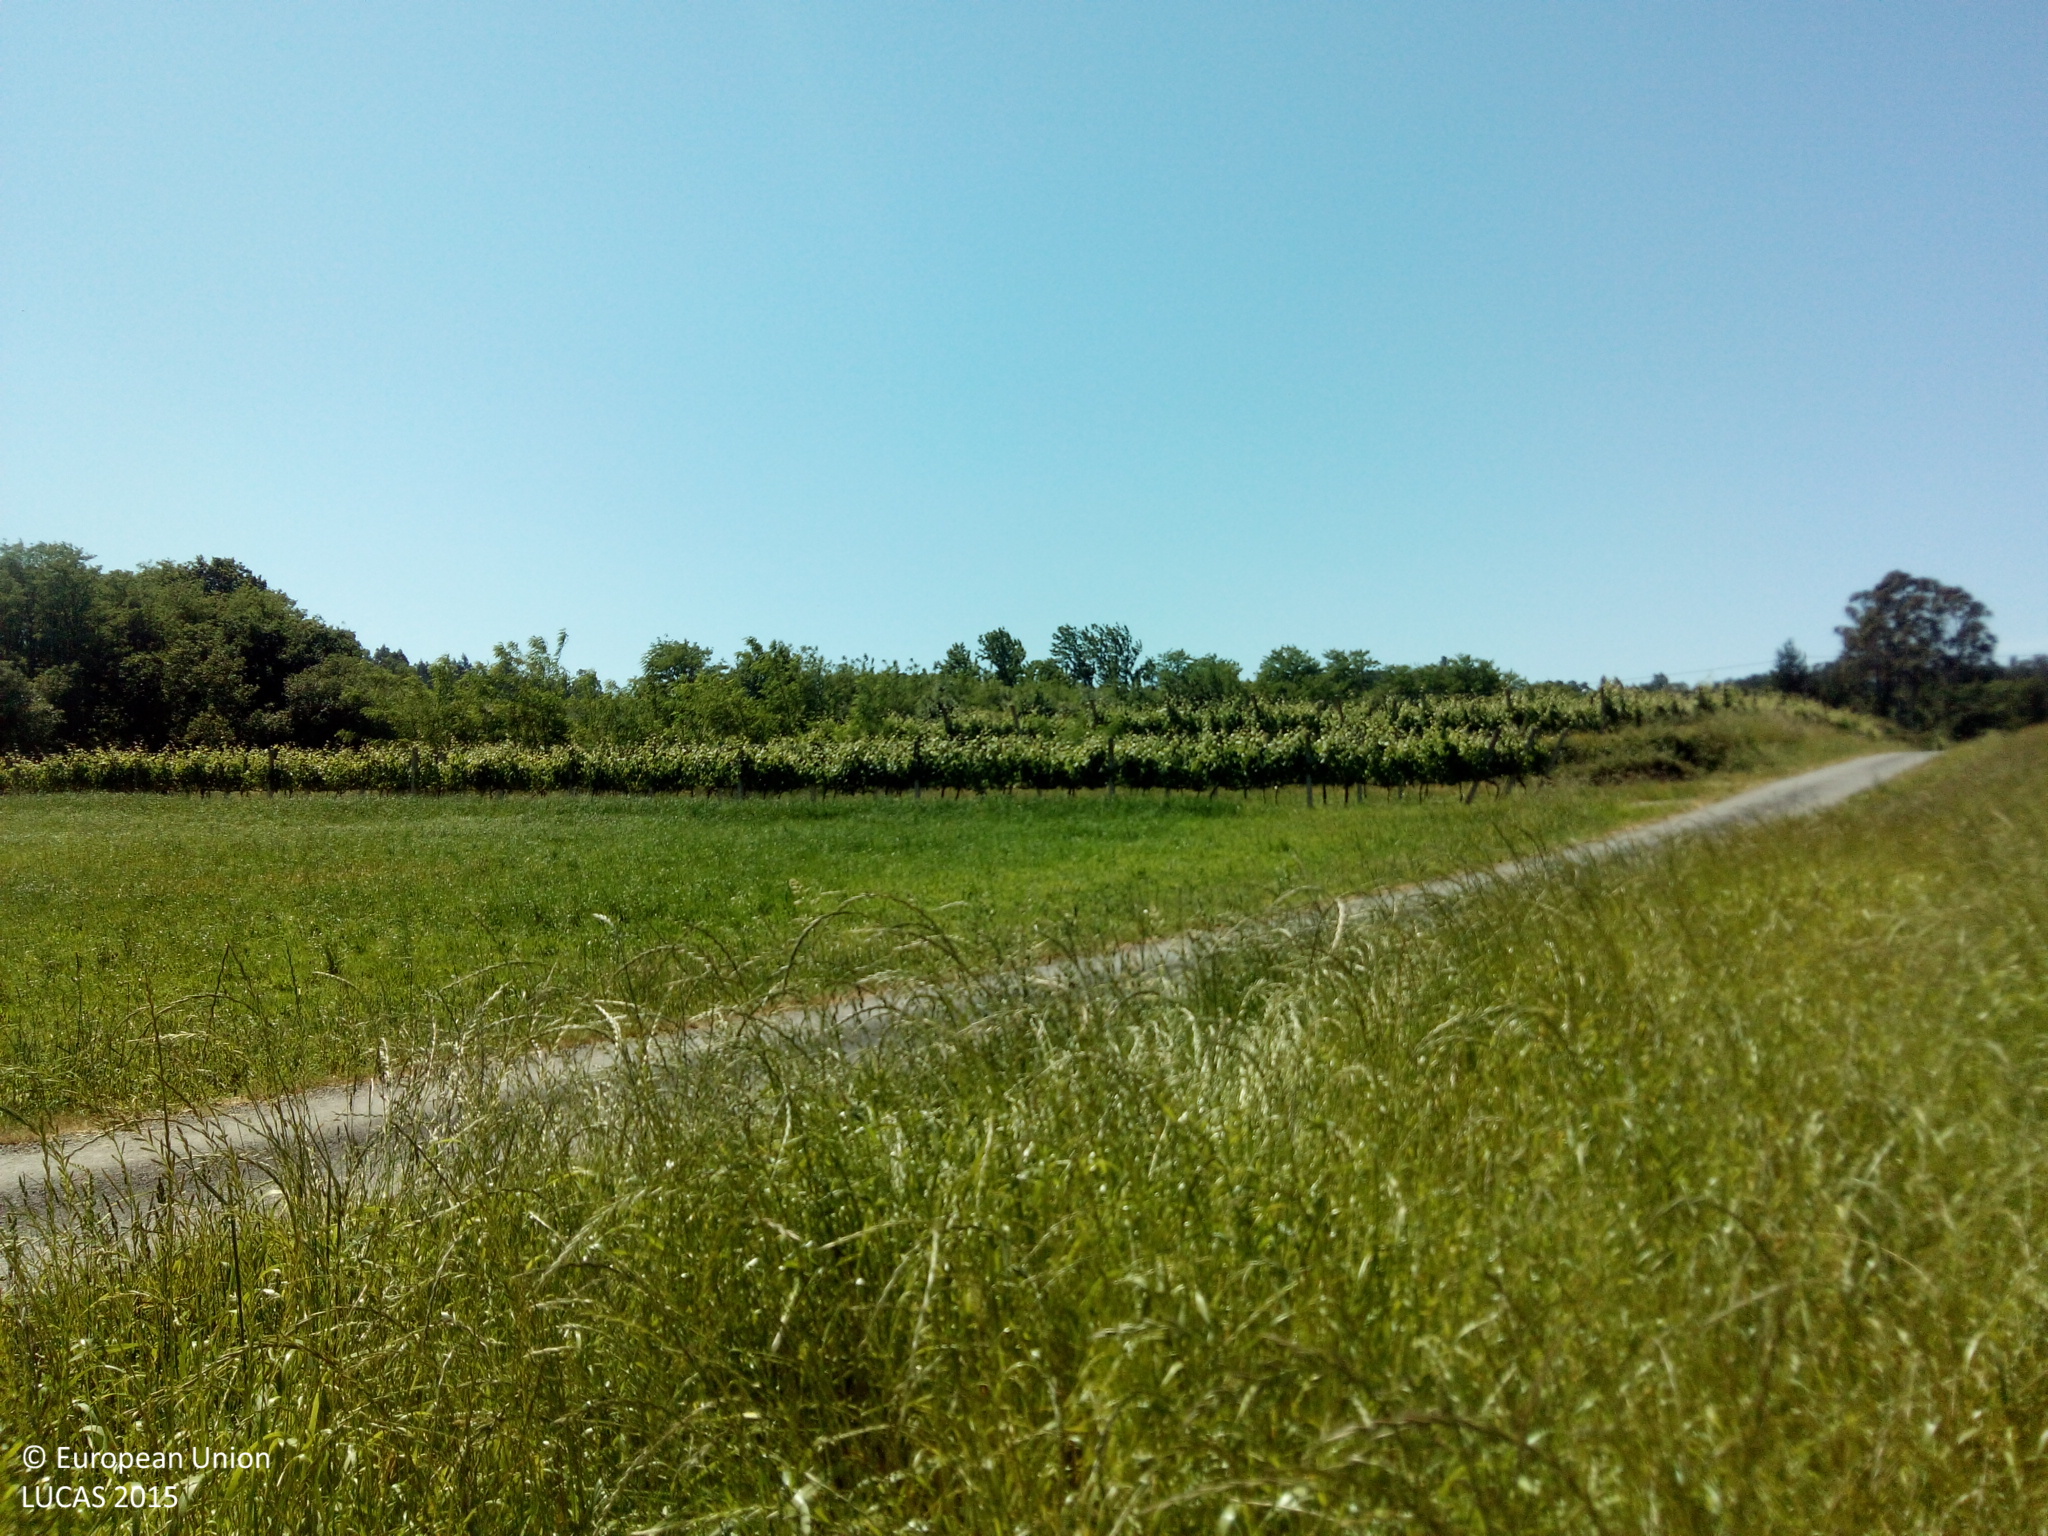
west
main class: Cropland
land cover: Temporary grasslands
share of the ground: > 75 %
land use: Agriculture (excluding fallow land and kitchen gardens)
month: May
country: ES
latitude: 42.7716
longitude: -8.4448
